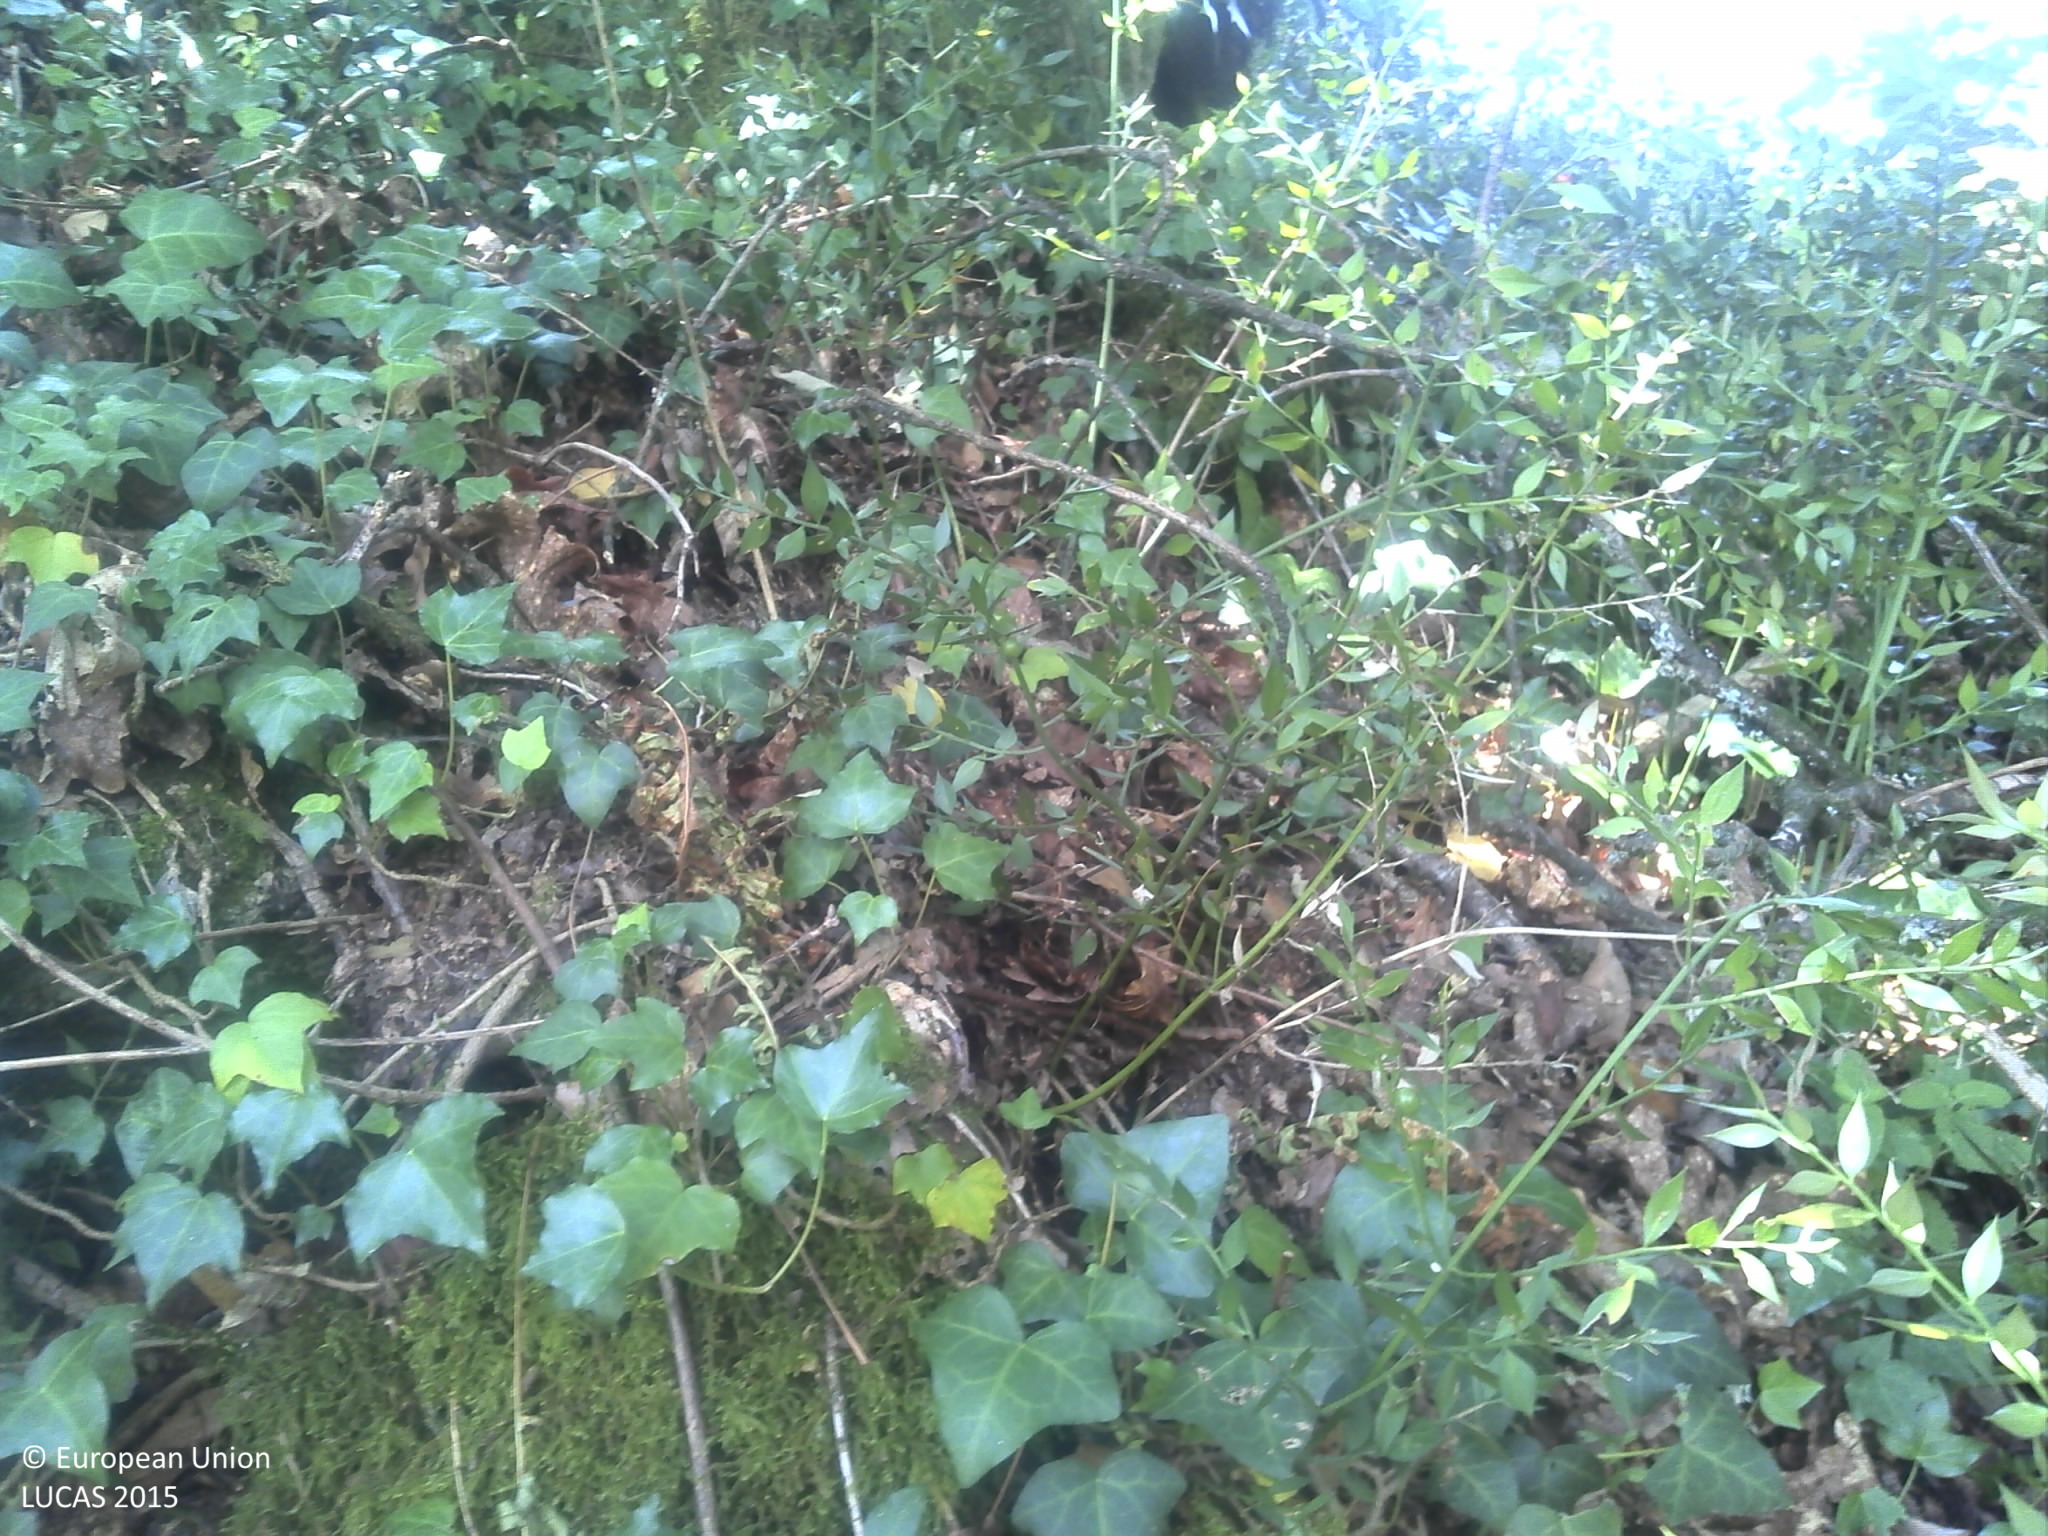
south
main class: Woodland
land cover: Broadleaved woodland
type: acidophilous oak and oak-birch forest
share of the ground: > 75 %
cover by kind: broadleaved forest trees 75 %, shrubs 10 %, herbaceous plants 10 %, unconsolidated bare surface 5 %
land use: Forestry
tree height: > 5 m
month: June
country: PT
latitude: 41.7414
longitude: -8.2235
